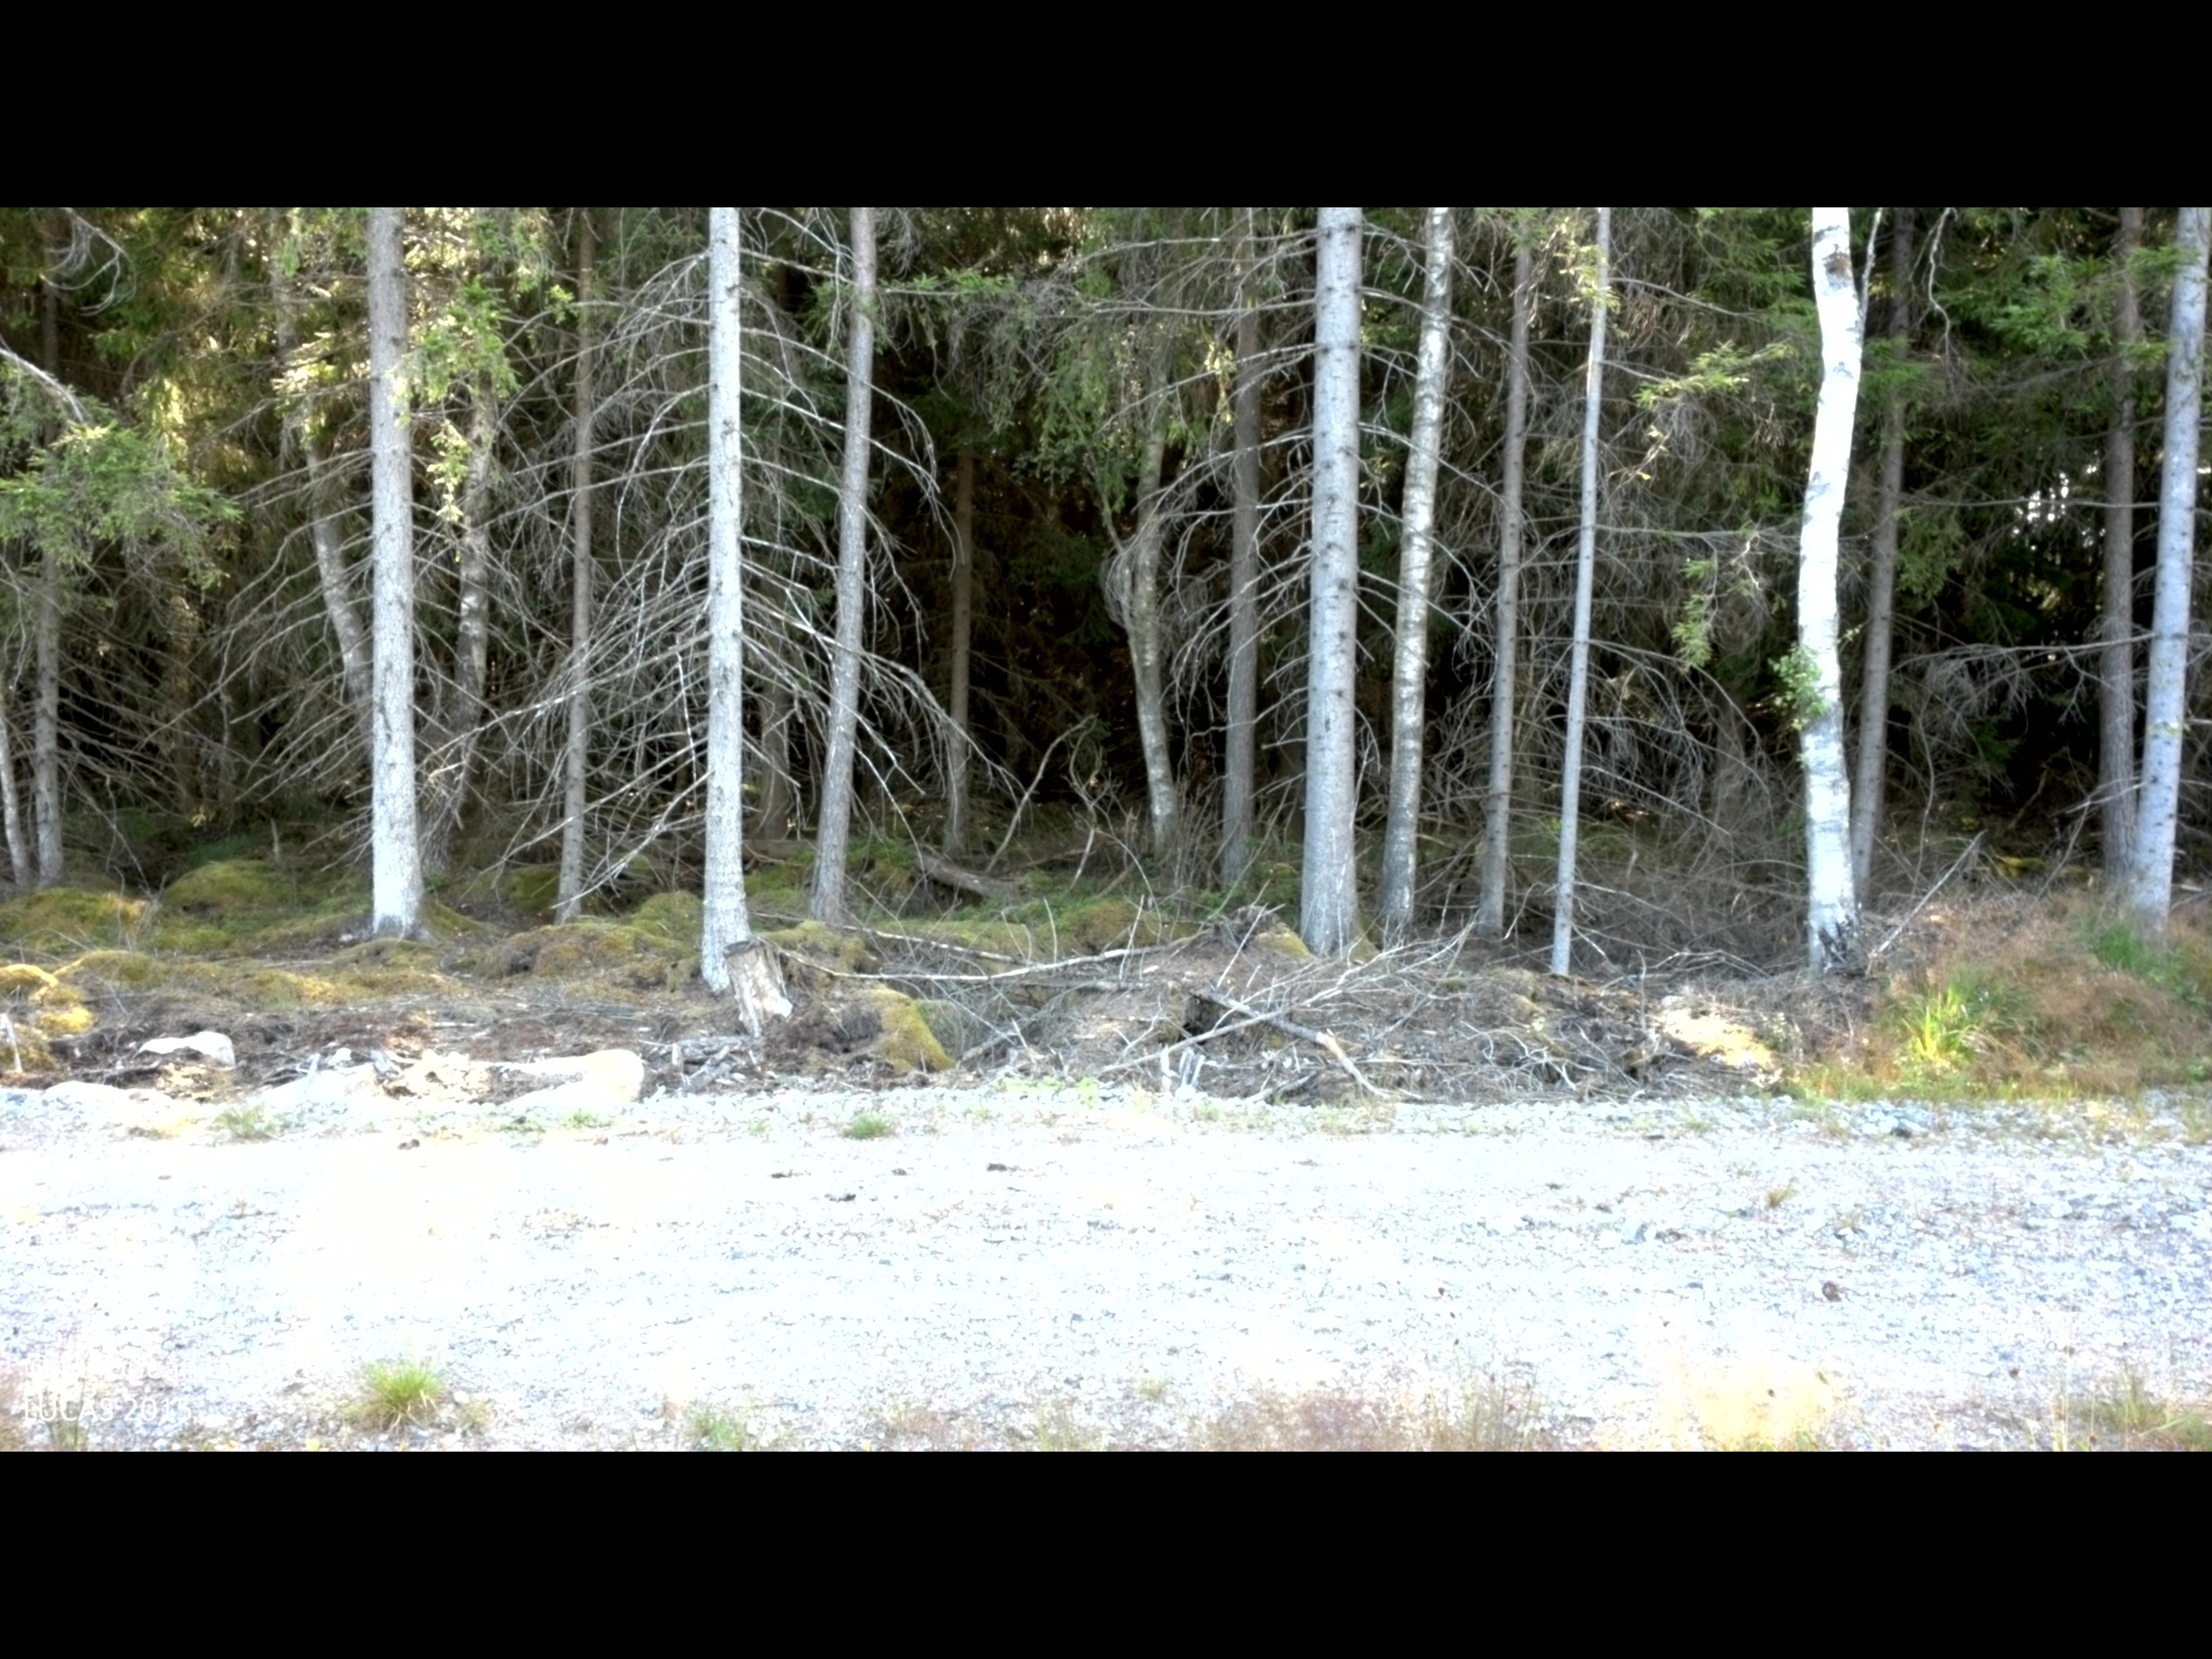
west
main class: Grassland
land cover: Grassland without tree/shrub cover
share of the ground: > 75 %
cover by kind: herbaceous plants 90 %, unconsolidated bare surface 10 %
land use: Forestry
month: August
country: SE
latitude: 56.6885
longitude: 13.8335
